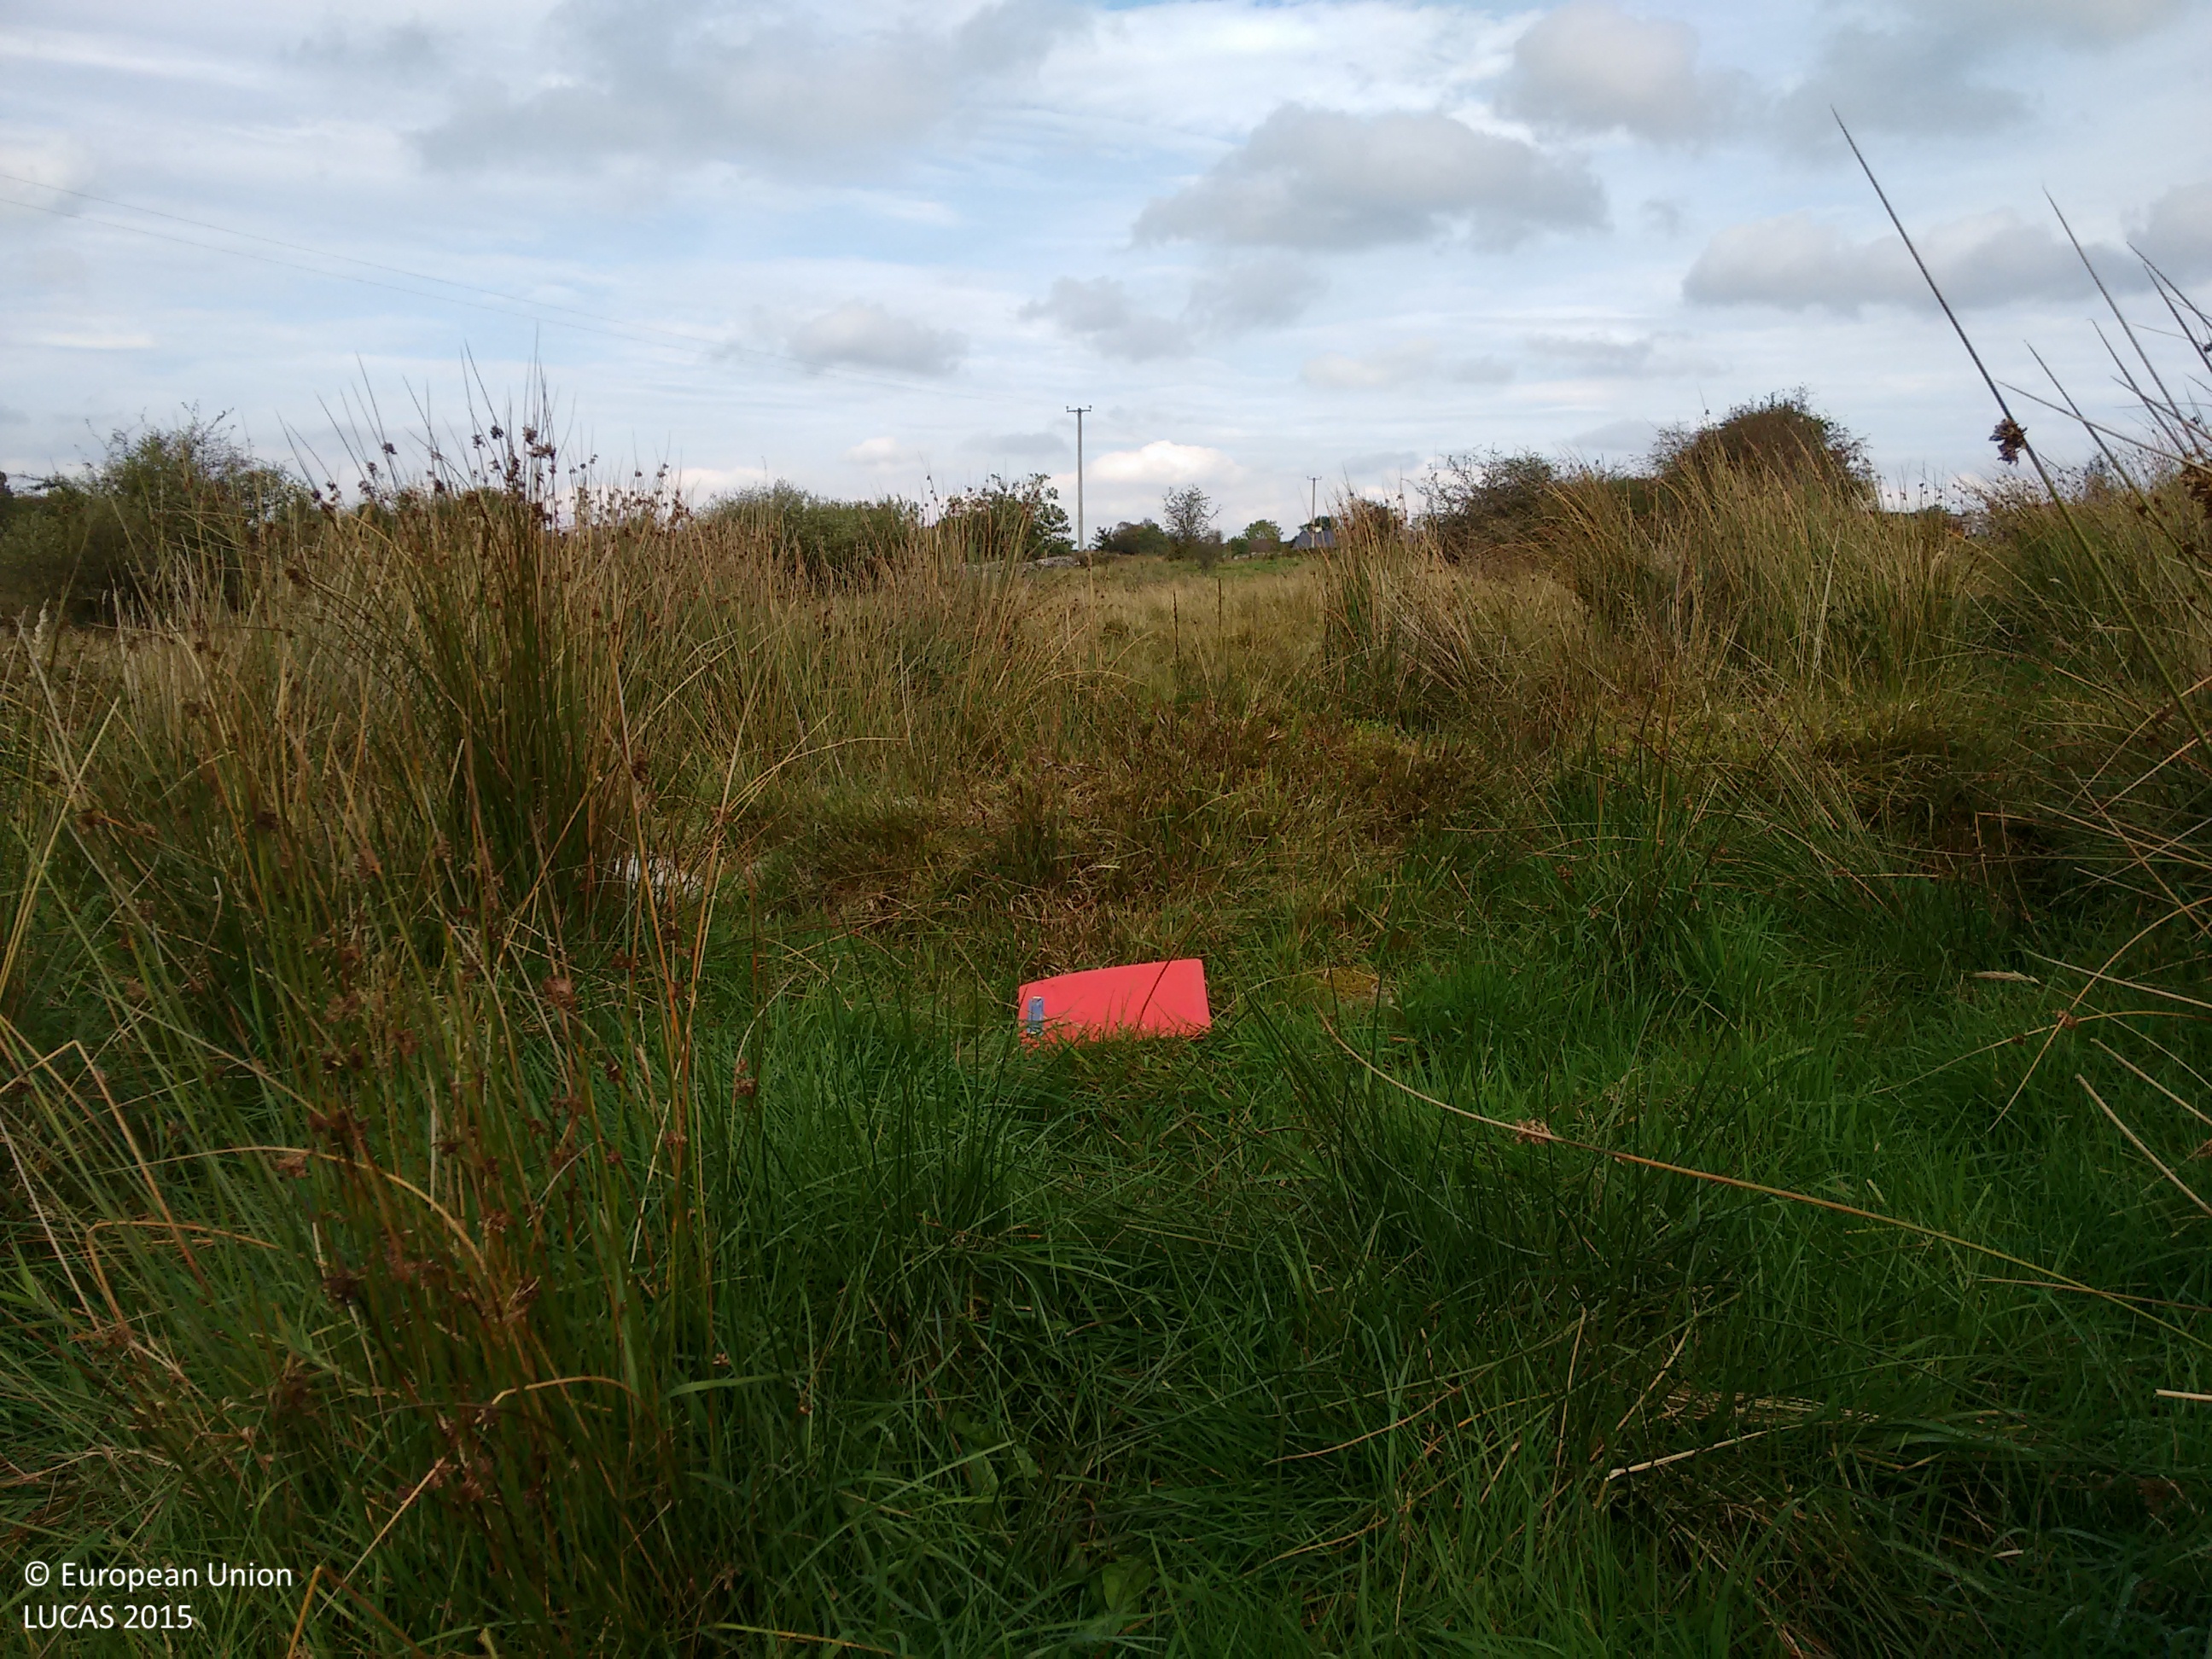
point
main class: Grassland
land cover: Grassland without tree/shrub cover
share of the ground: > 75 %
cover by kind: herbaceous plants 100 %
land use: Agriculture (excluding fallow land and kitchen gardens)
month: September
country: IE
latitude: 53.8811
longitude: -8.9672
